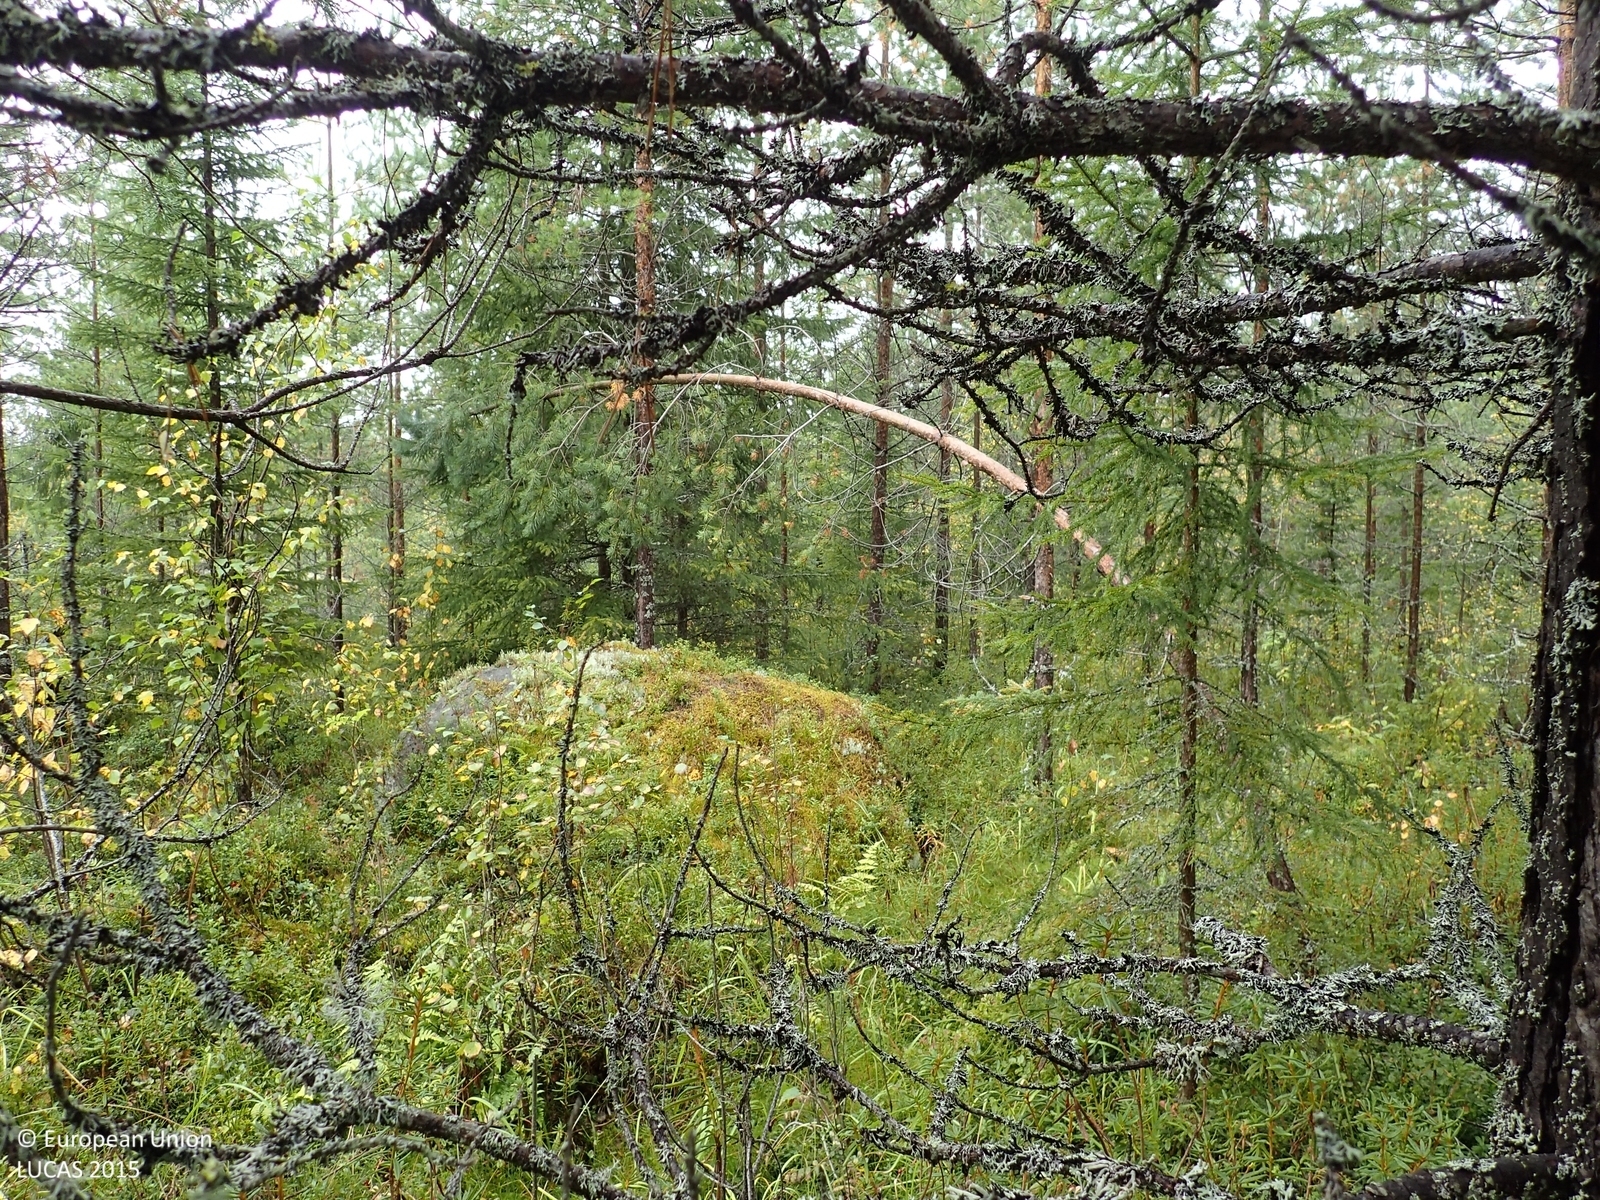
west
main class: Woodland
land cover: Pine dominated coniferous woodland
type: boreal forest
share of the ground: 50 - 75 %
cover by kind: coniferous forest trees 60 %, shrubs 20 %, broadleaved forest trees 10 %, herbaceous plants 5 %, lichens and mosses 5 %
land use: Forestry
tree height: > 5 m
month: September
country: FI
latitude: 63.2320
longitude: 25.7735
